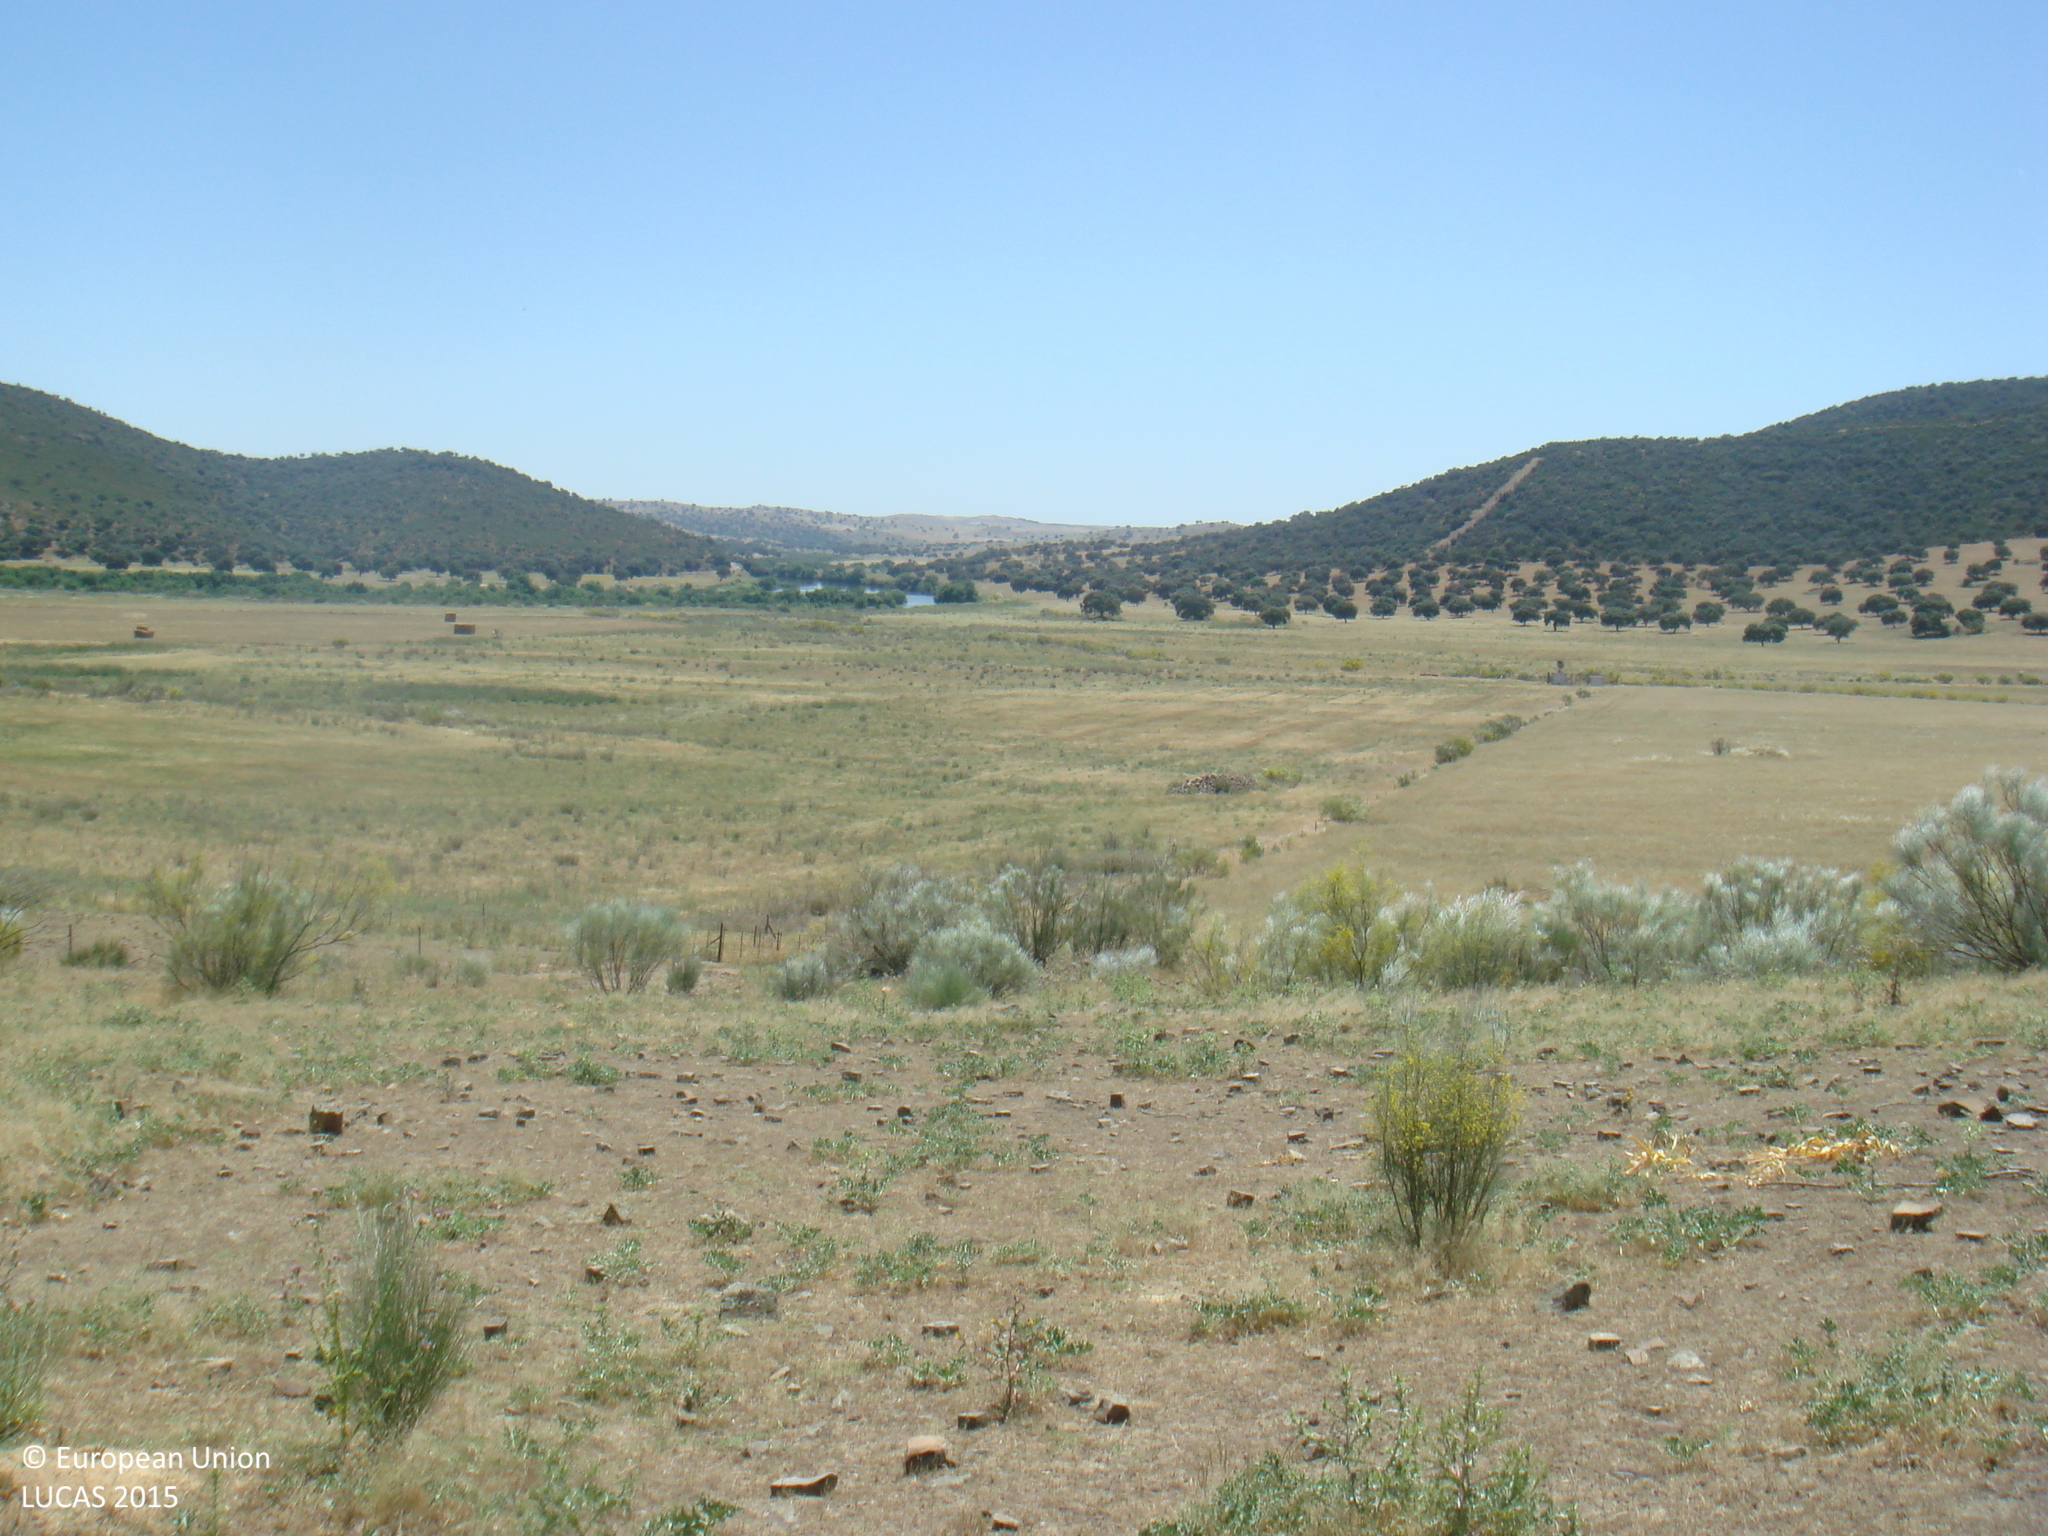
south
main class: Shrubland
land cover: Shrubland without tree cover
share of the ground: 10 - 25 %
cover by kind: herbaceous plants 75 %, shrubs 20 %
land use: Agriculture (excluding fallow land and kitchen gardens)
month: May
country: ES
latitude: 38.7039
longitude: -5.1076
